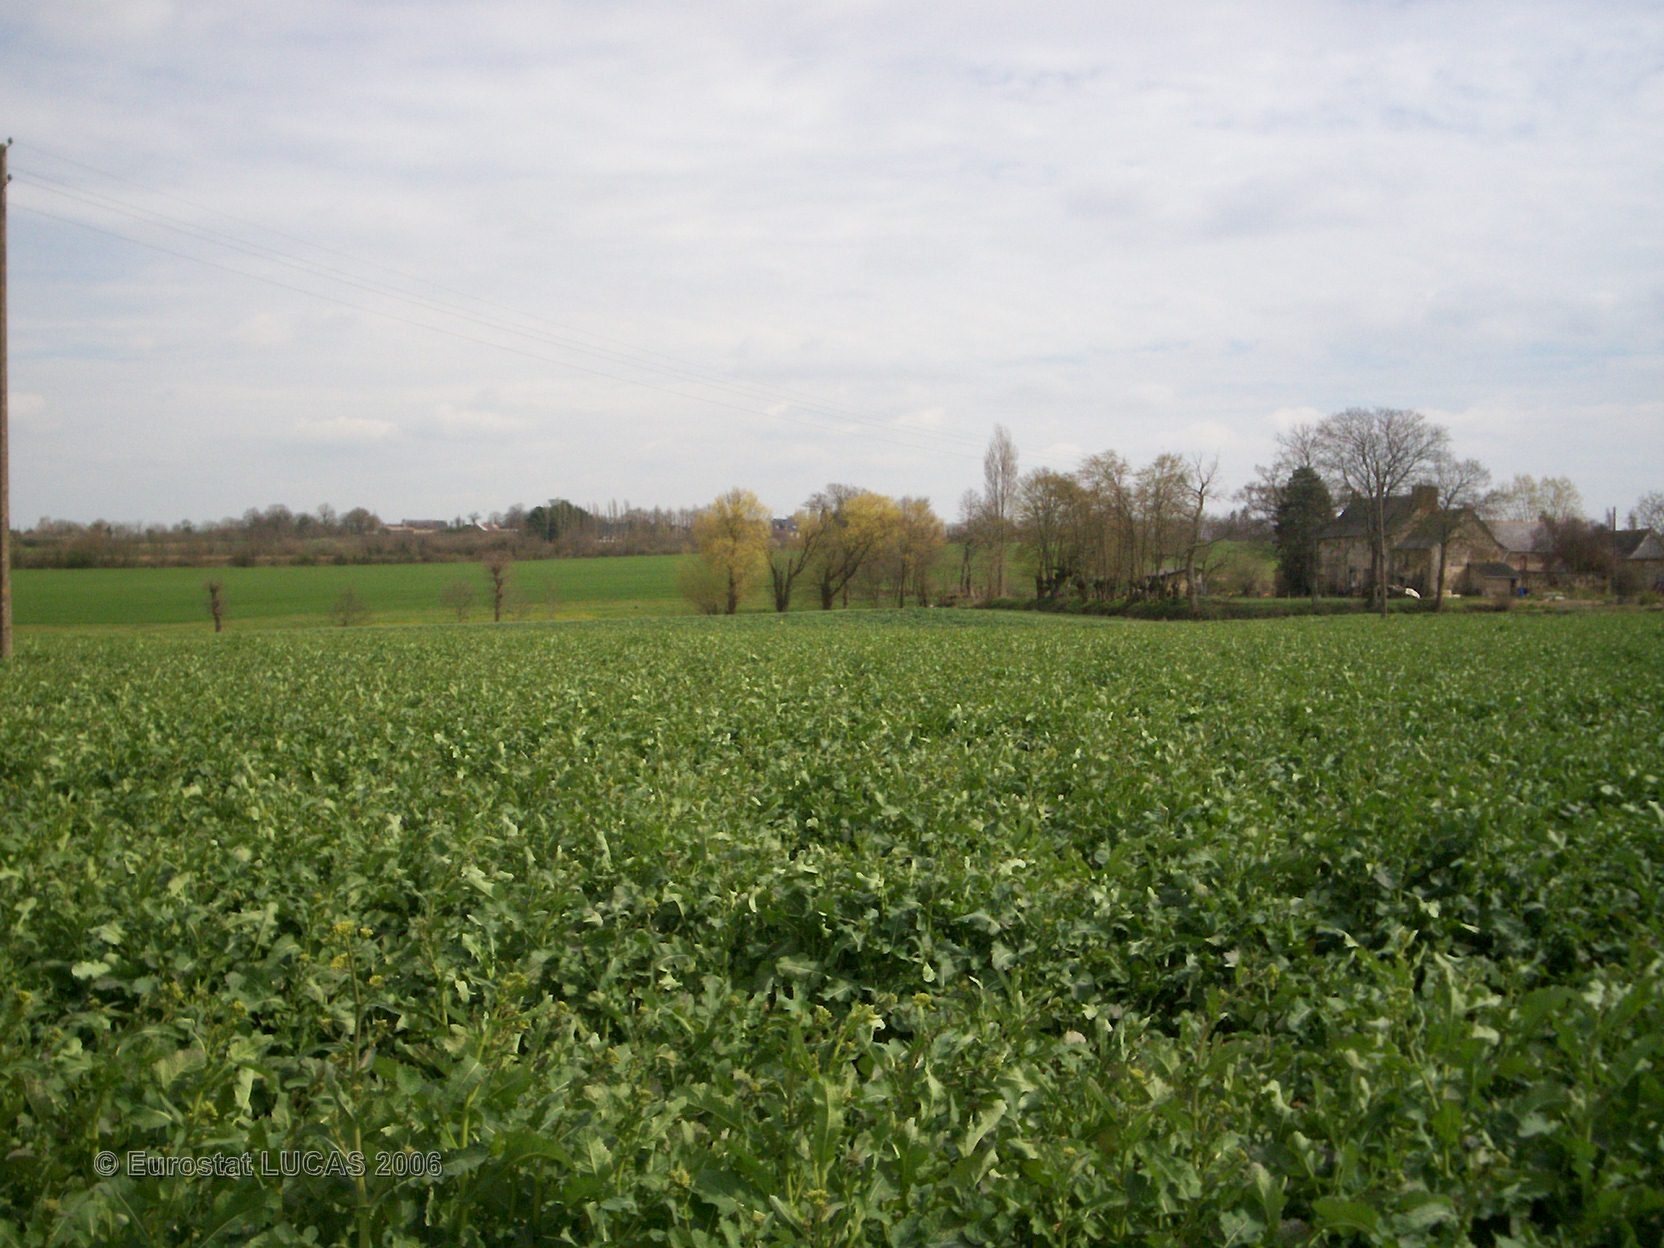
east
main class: Cropland
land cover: Rape and turnip rape
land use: Agriculture (excluding fallow land and kitchen gardens)
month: April
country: FR
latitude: 47.9923
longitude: -1.5841
